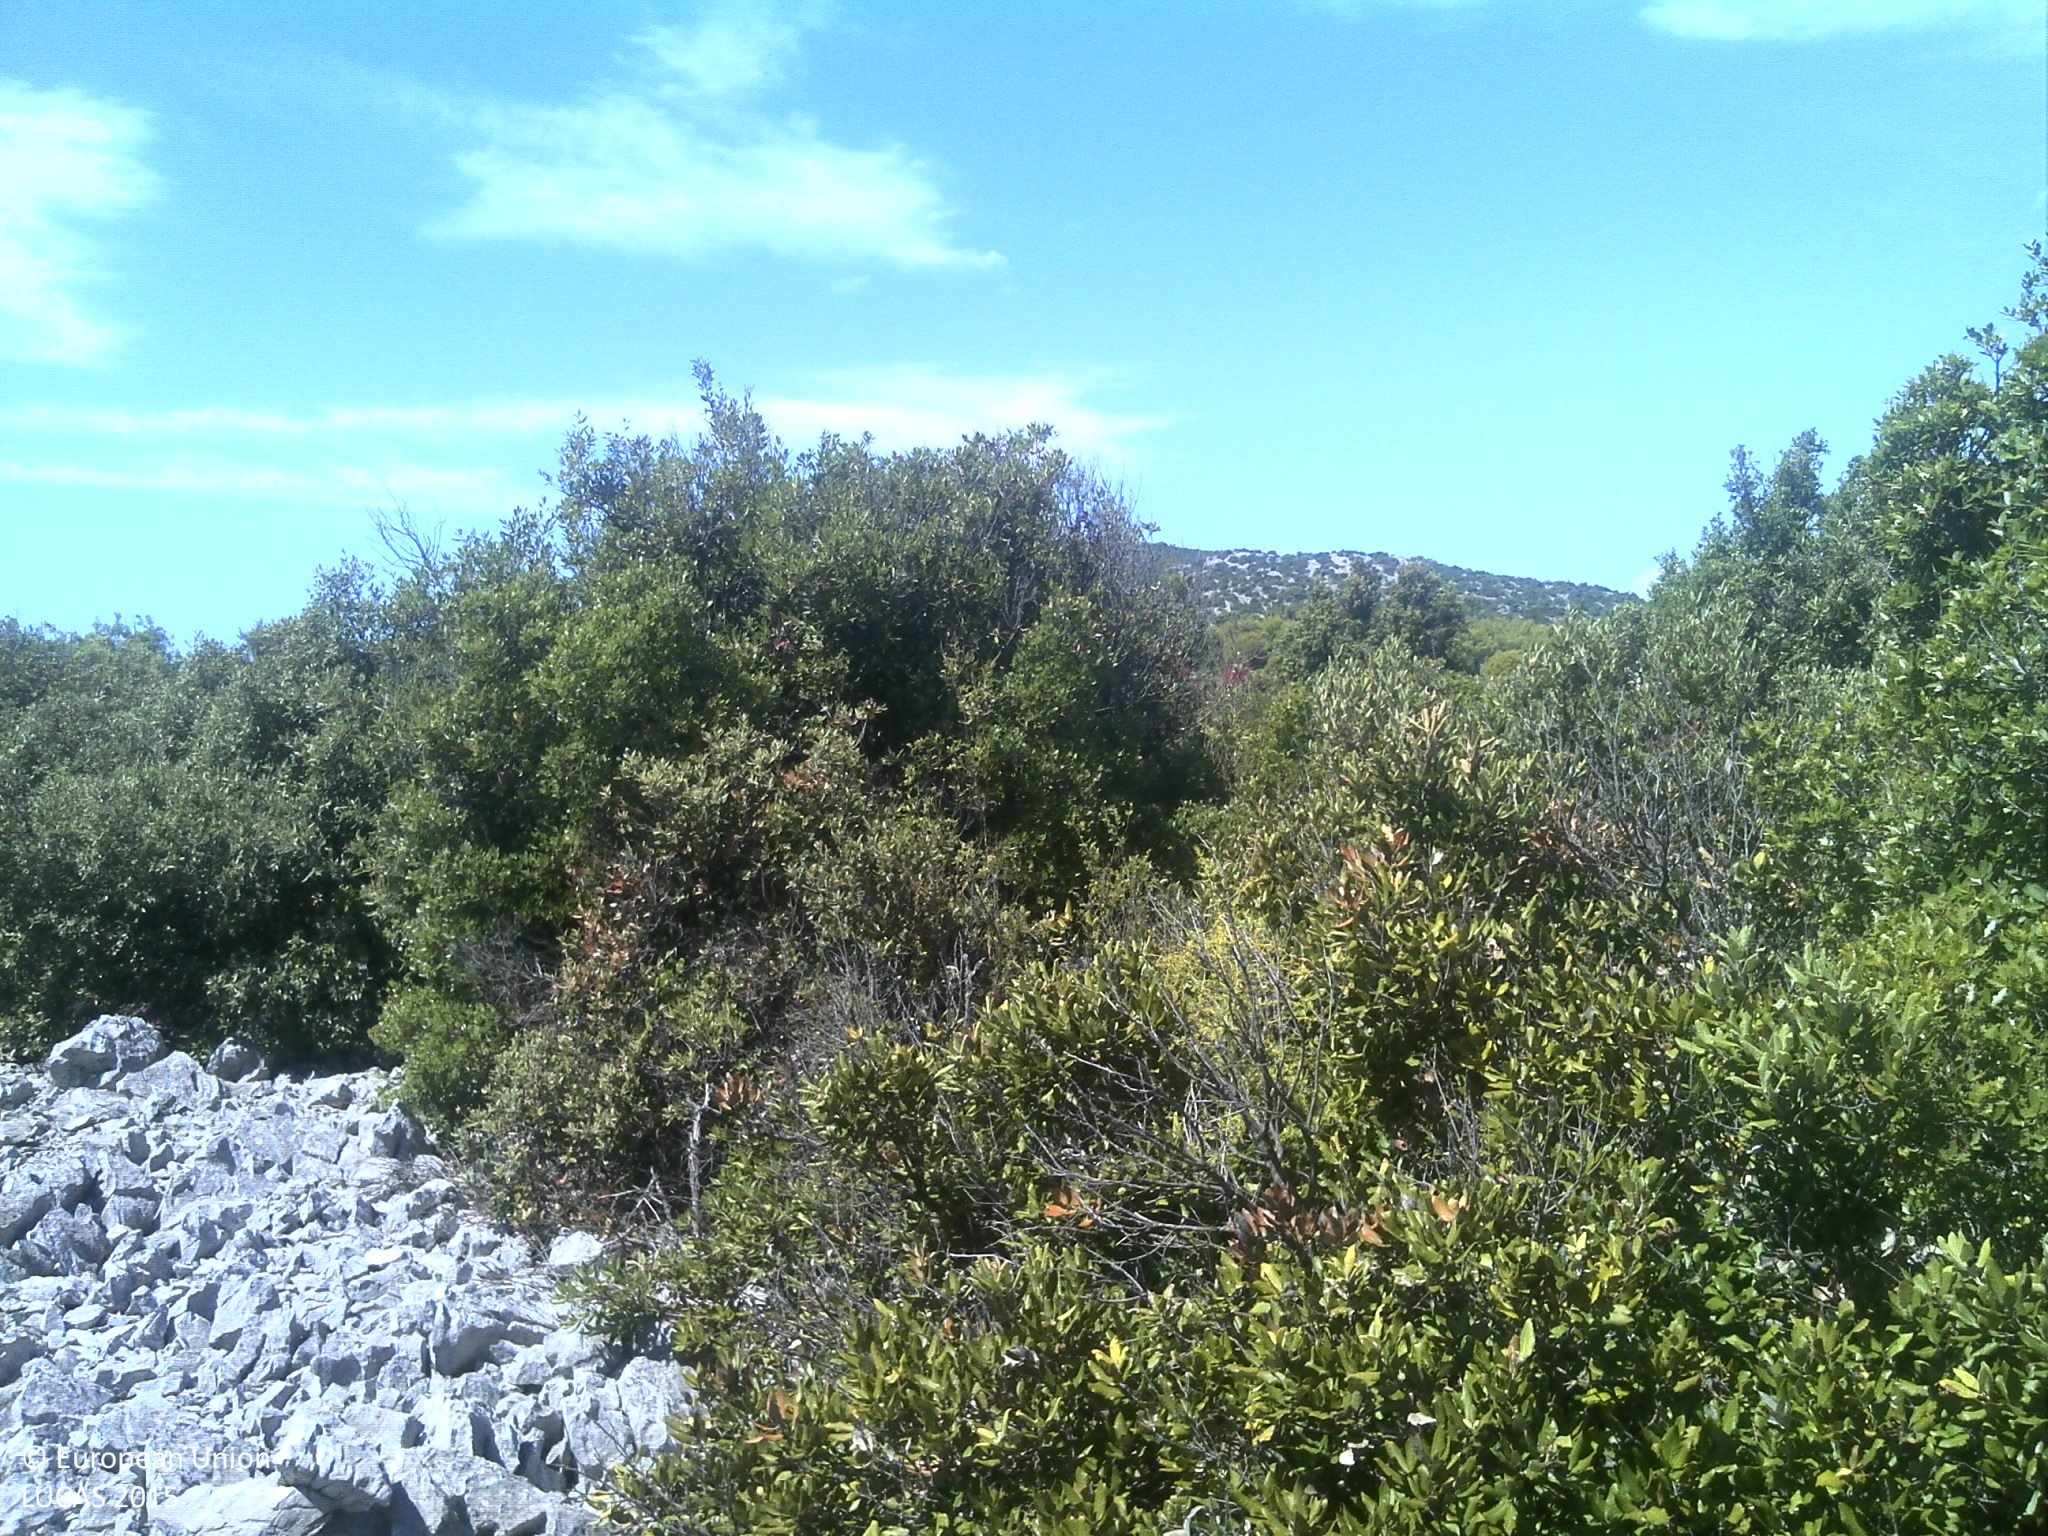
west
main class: Shrubland
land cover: Shrubland without tree cover
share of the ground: > 75 %
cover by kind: shrubs 75 %, consolidated bare surface 25 %
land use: Semi-natural and natural areas not in use
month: August
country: HR
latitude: 43.8350
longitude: 15.6498
